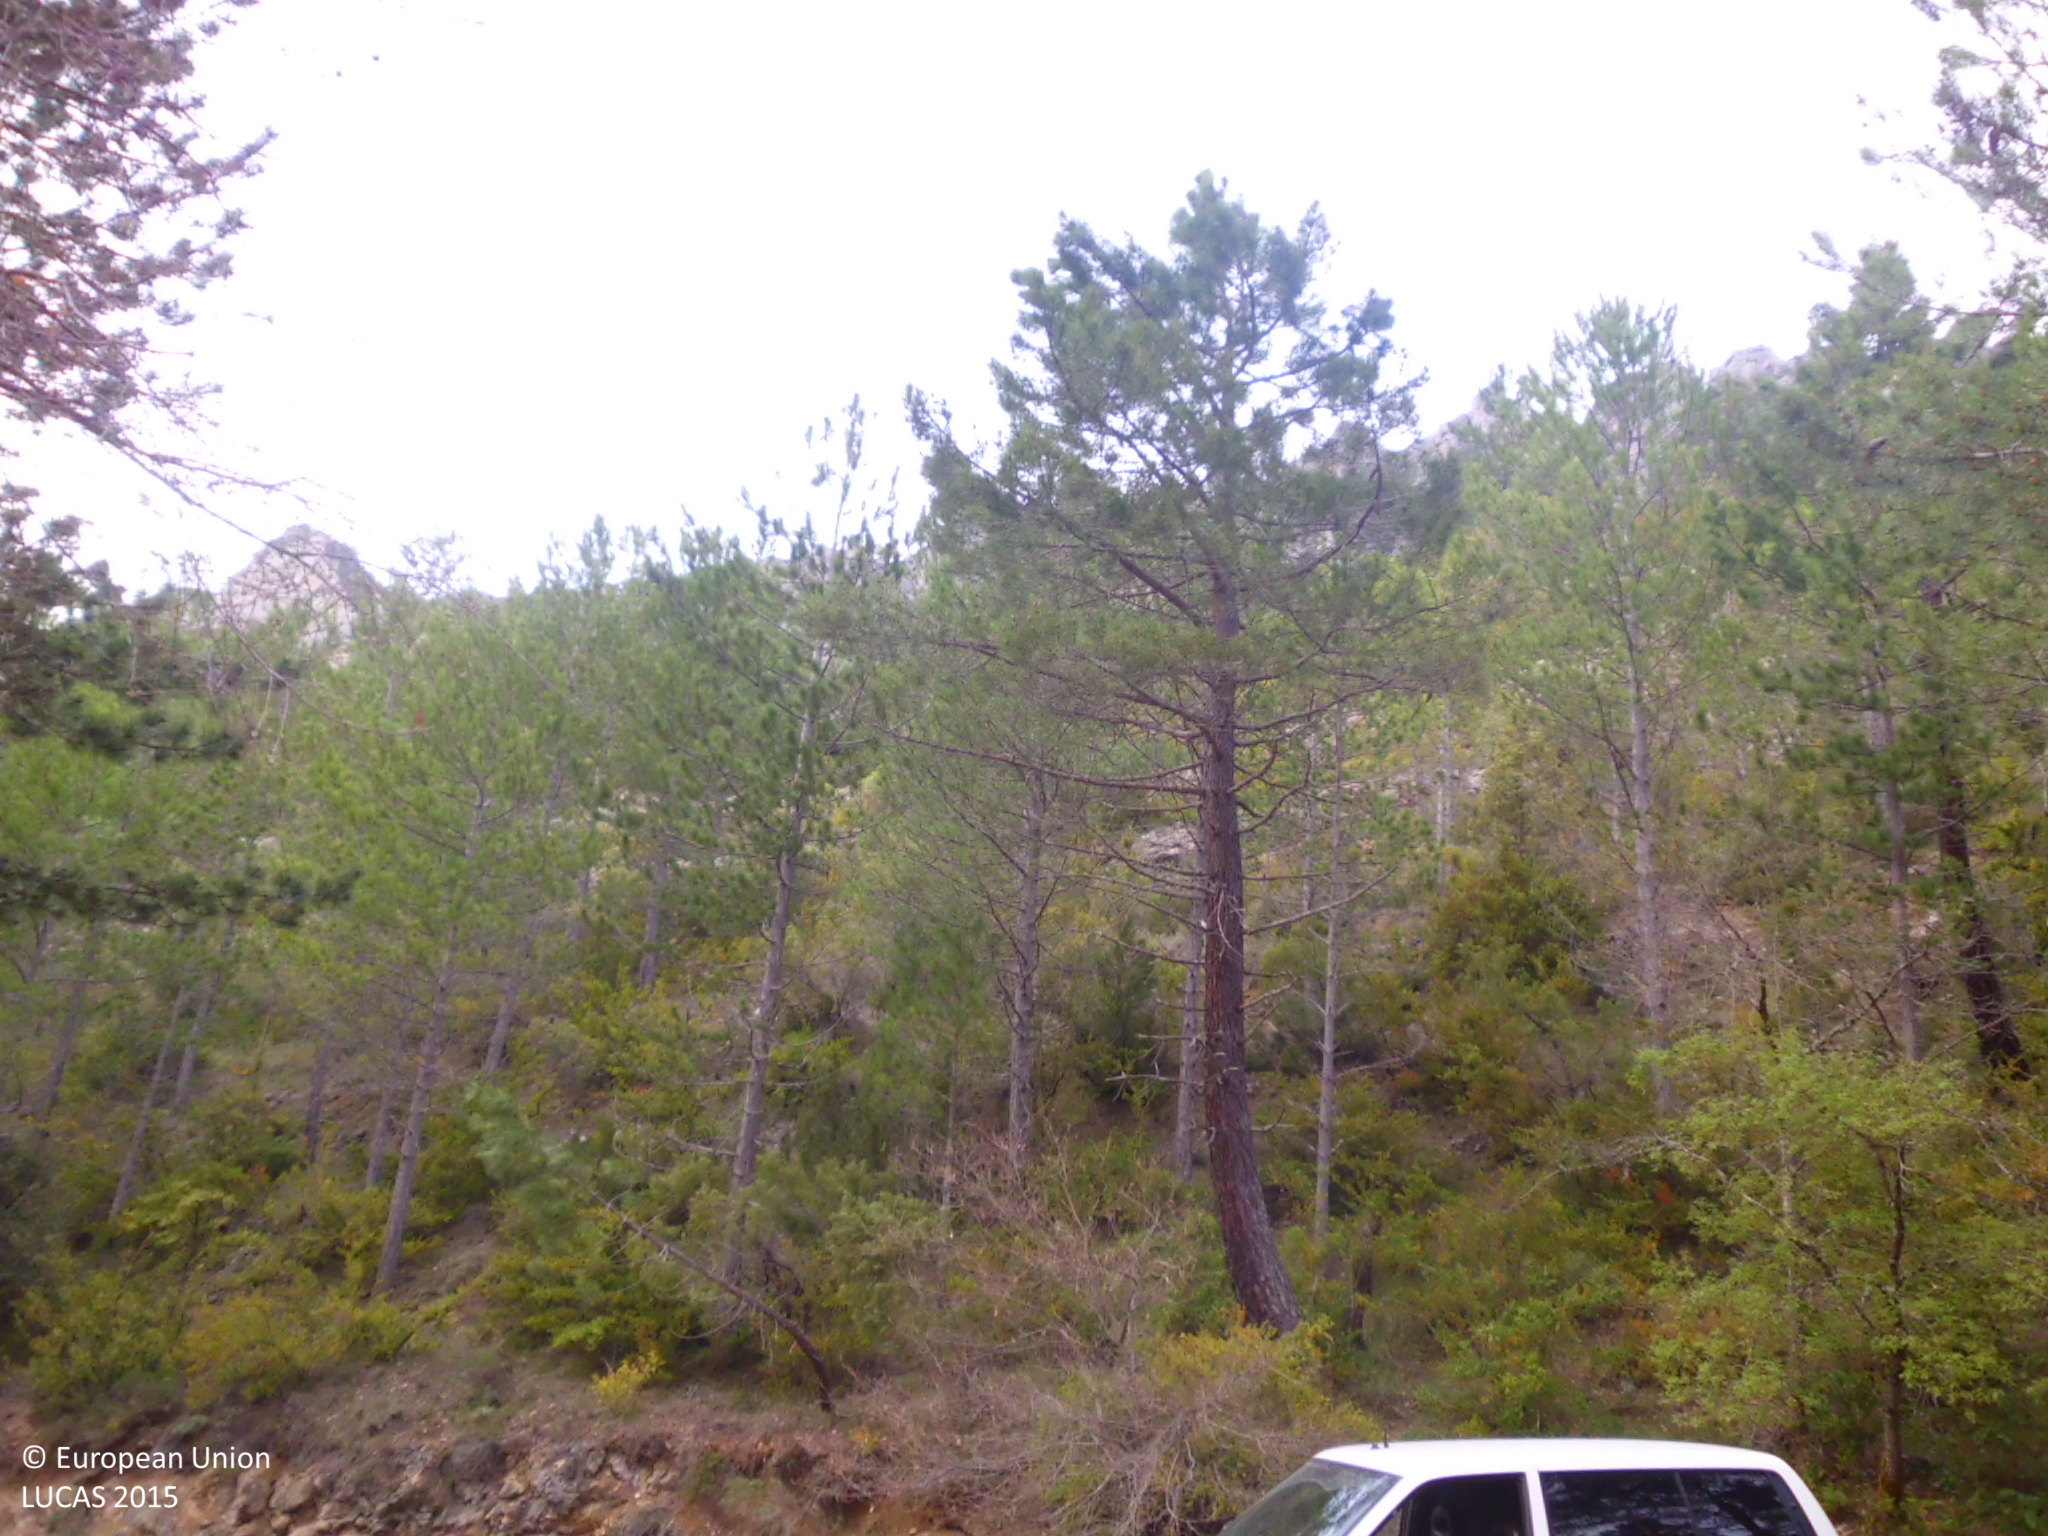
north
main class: Woodland
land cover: Pine dominated mixed woodland
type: coniferous forest of the mediterranean region
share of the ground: > 75 %
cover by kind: coniferous forest trees 55 %, broadleaved forest trees 20 %, shrubs 15 %, herbaceous plants 10 %
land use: Semi-natural and natural areas not in use
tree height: > 5 m
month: April
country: ES
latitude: 42.7945
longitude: -3.4491
